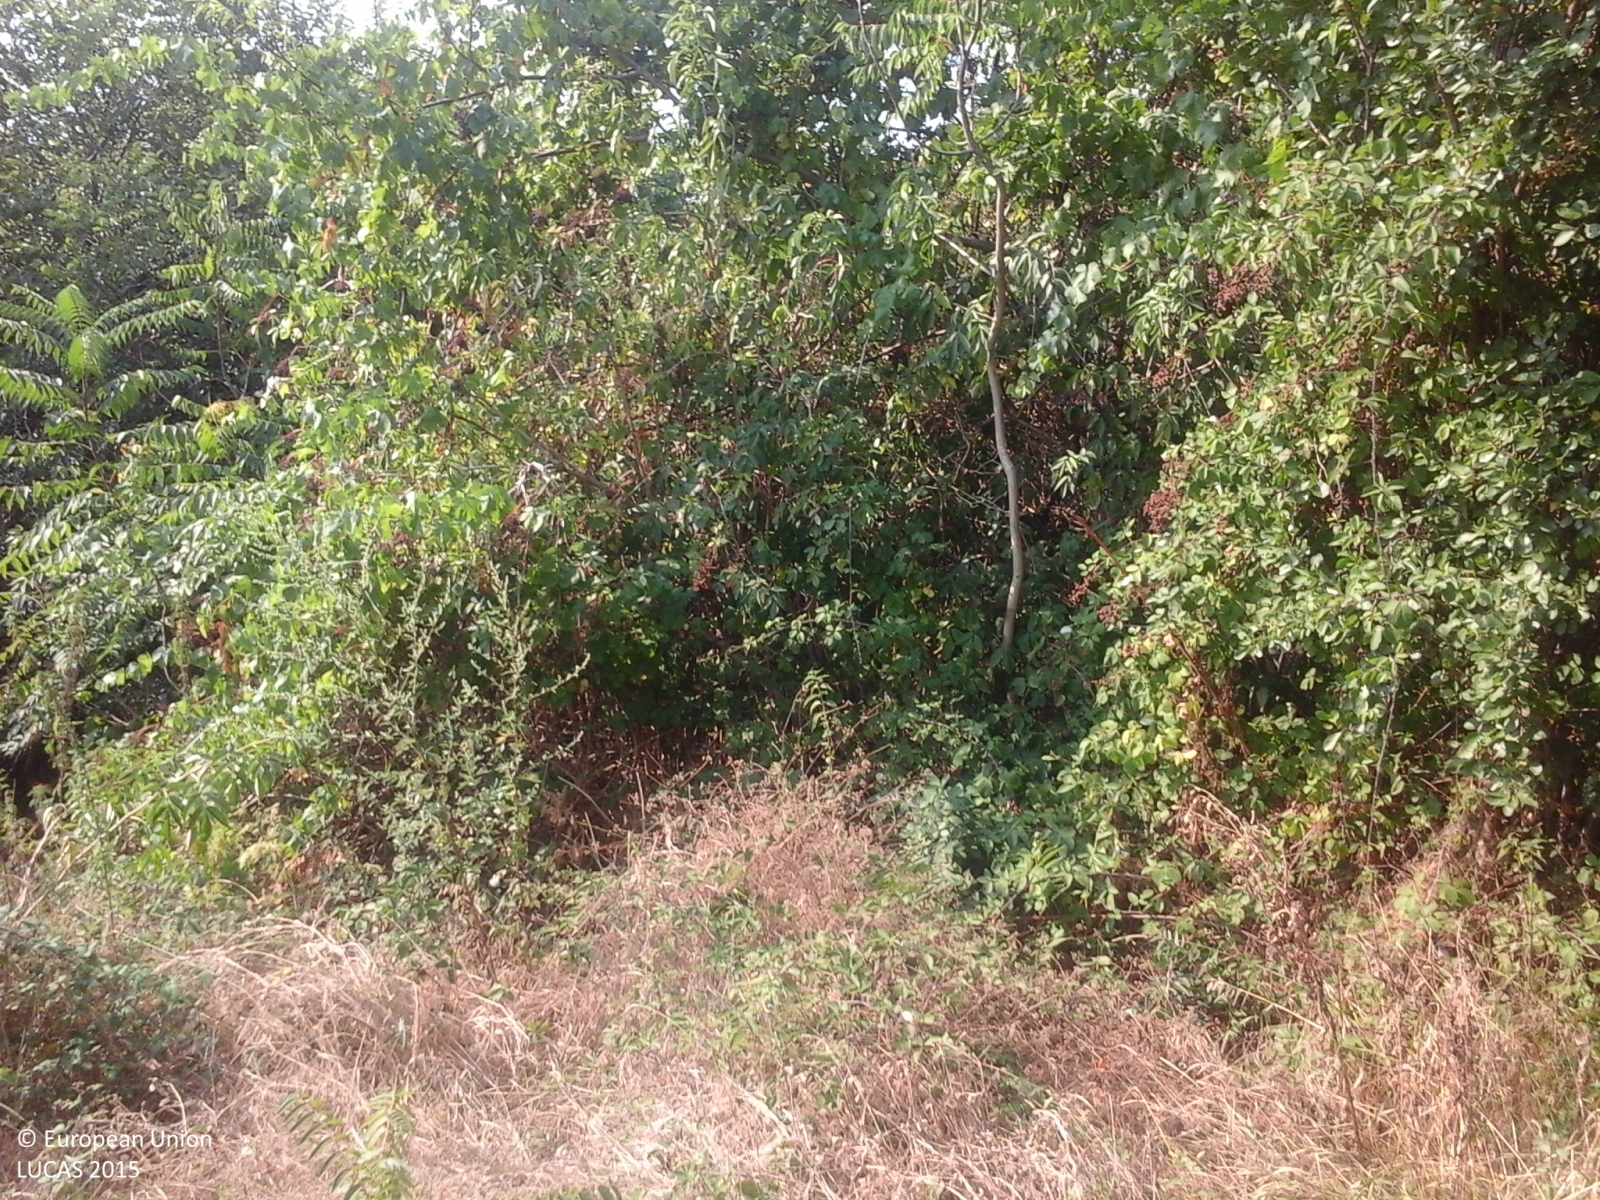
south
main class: Woodland
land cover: Broadleaved woodland
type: thermophilous deciduous forest
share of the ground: > 75 %
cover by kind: broadleaved forest trees 100 %
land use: Forestry
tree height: > 5 m
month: August
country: IT
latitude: 43.8171
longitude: 12.4185
